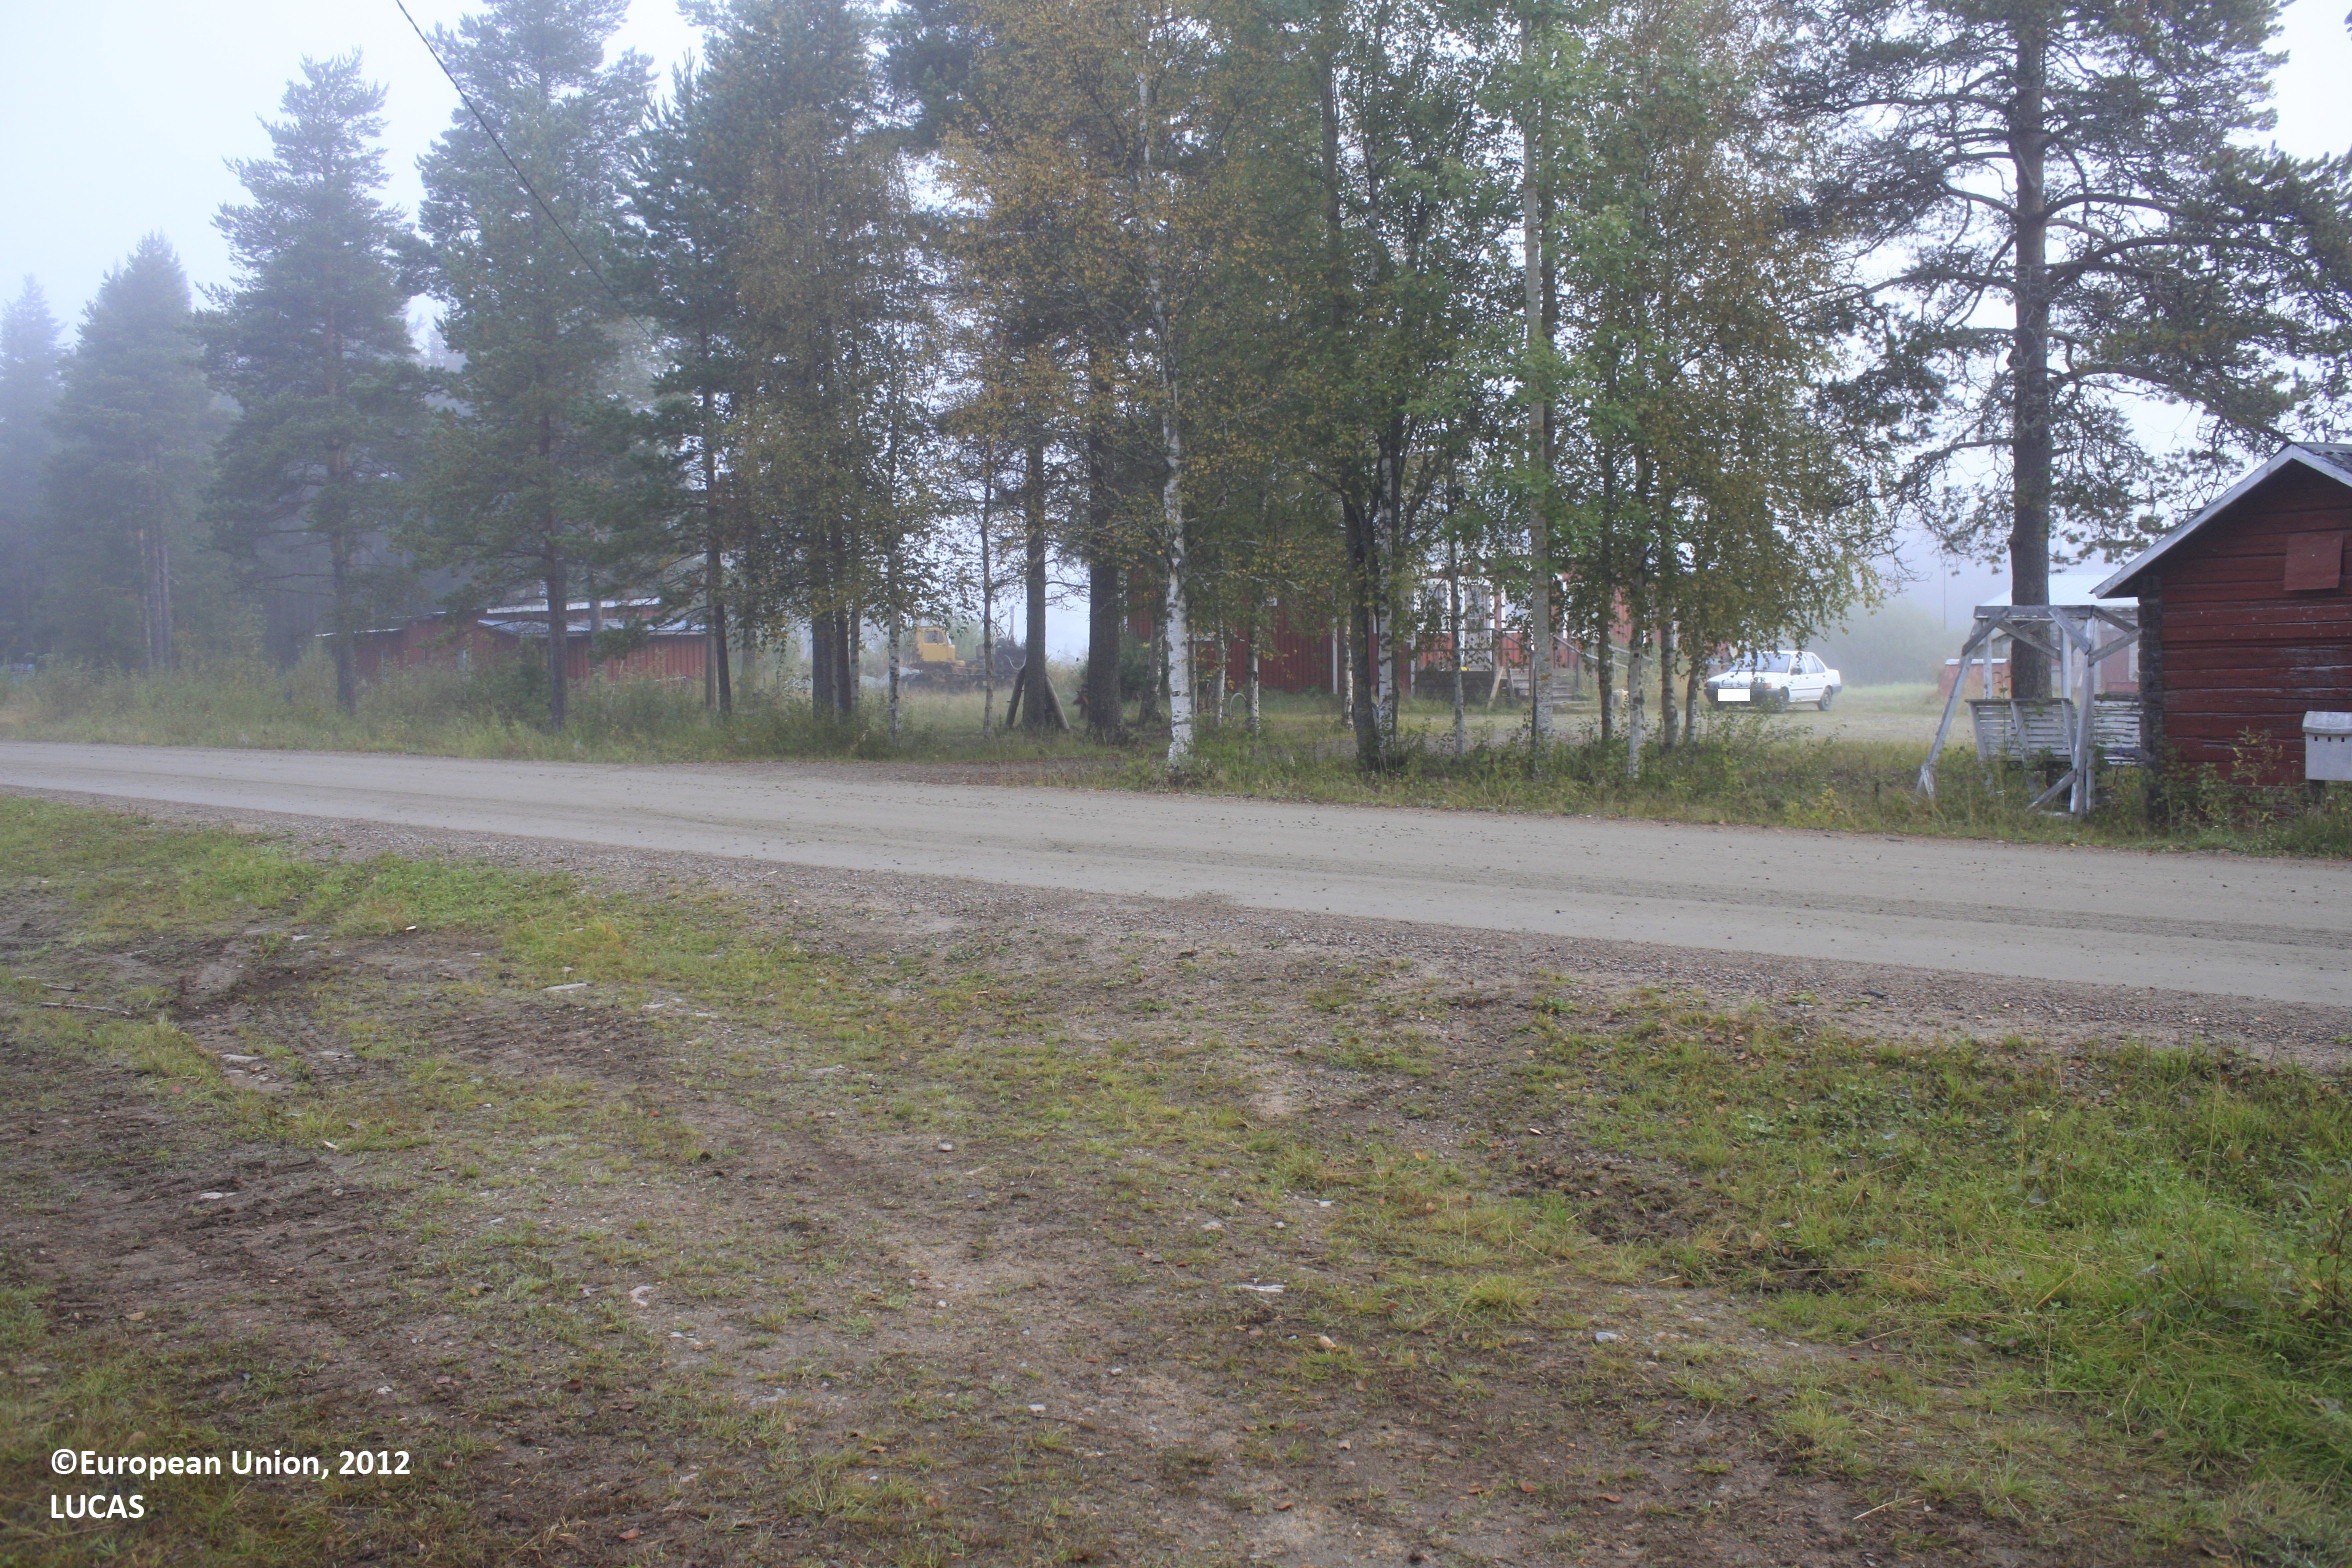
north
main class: Grassland
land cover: Grassland with sparse tree/shrub cover
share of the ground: 50 - 75 %
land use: Agriculture (excluding fallow land and kitchen gardens)
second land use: Logistics and storage
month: September
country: FI
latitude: 65.1793
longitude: 26.8314
